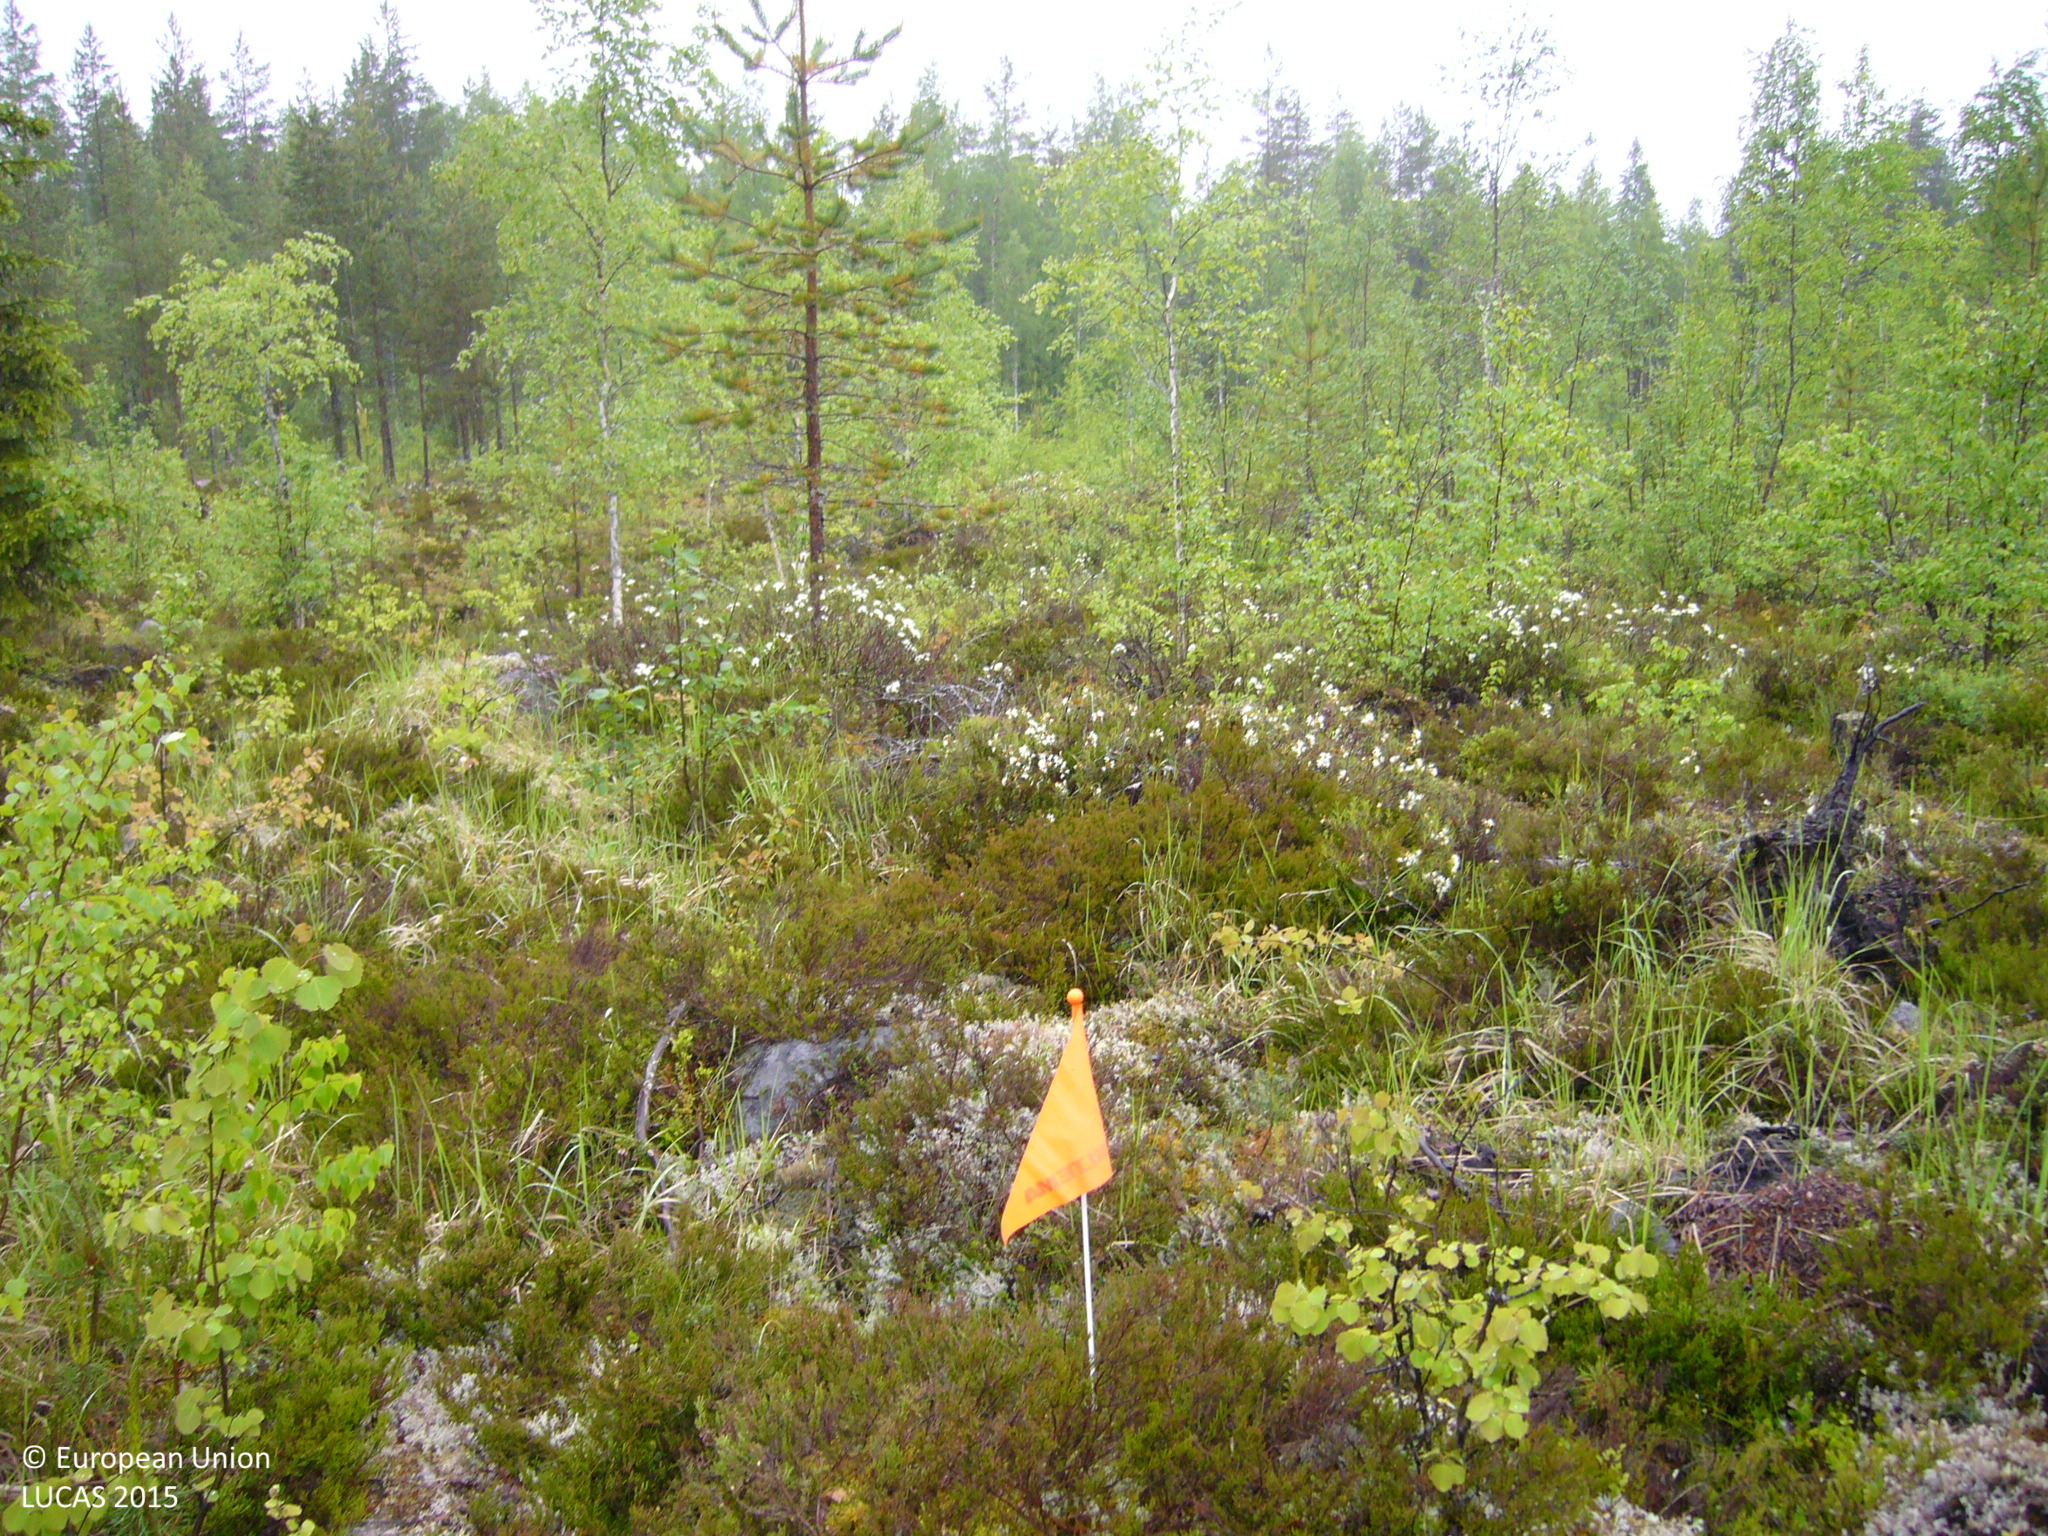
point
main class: Woodland
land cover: Pine dominated mixed woodland
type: boreal forest
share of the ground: 25 - 50 %
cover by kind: shrubs 65 %, coniferous forest trees 25 %, broadleaved forest trees 10 %
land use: Forestry
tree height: > 5 m
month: June
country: FI
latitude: 63.7685
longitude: 25.0331
